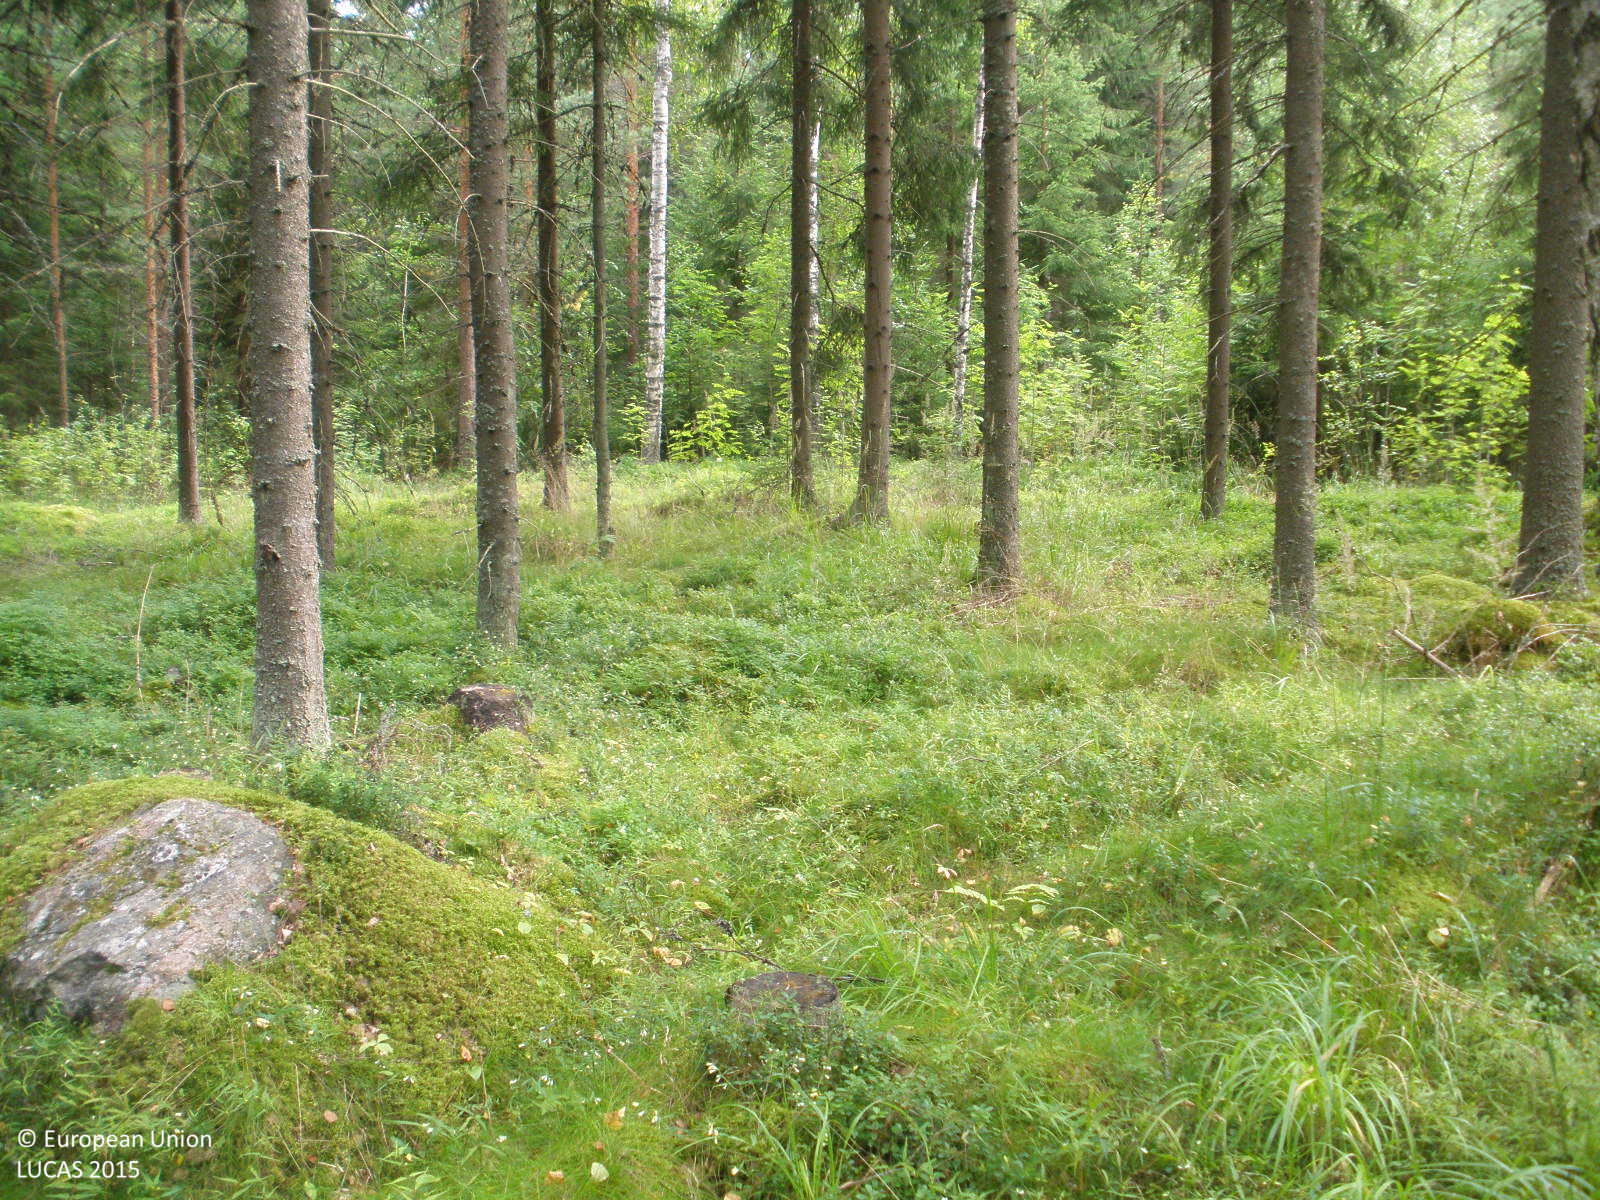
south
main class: Woodland
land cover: Spruce dominated coniferous woodland
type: boreal forest
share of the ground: > 75 %
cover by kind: coniferous forest trees 80 %, herbaceous plants 10 %, broadleaved forest trees 5 %, lichens and mosses 5 %
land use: Forestry
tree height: > 5 m
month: August
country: FI
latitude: 60.7365
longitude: 24.4259
